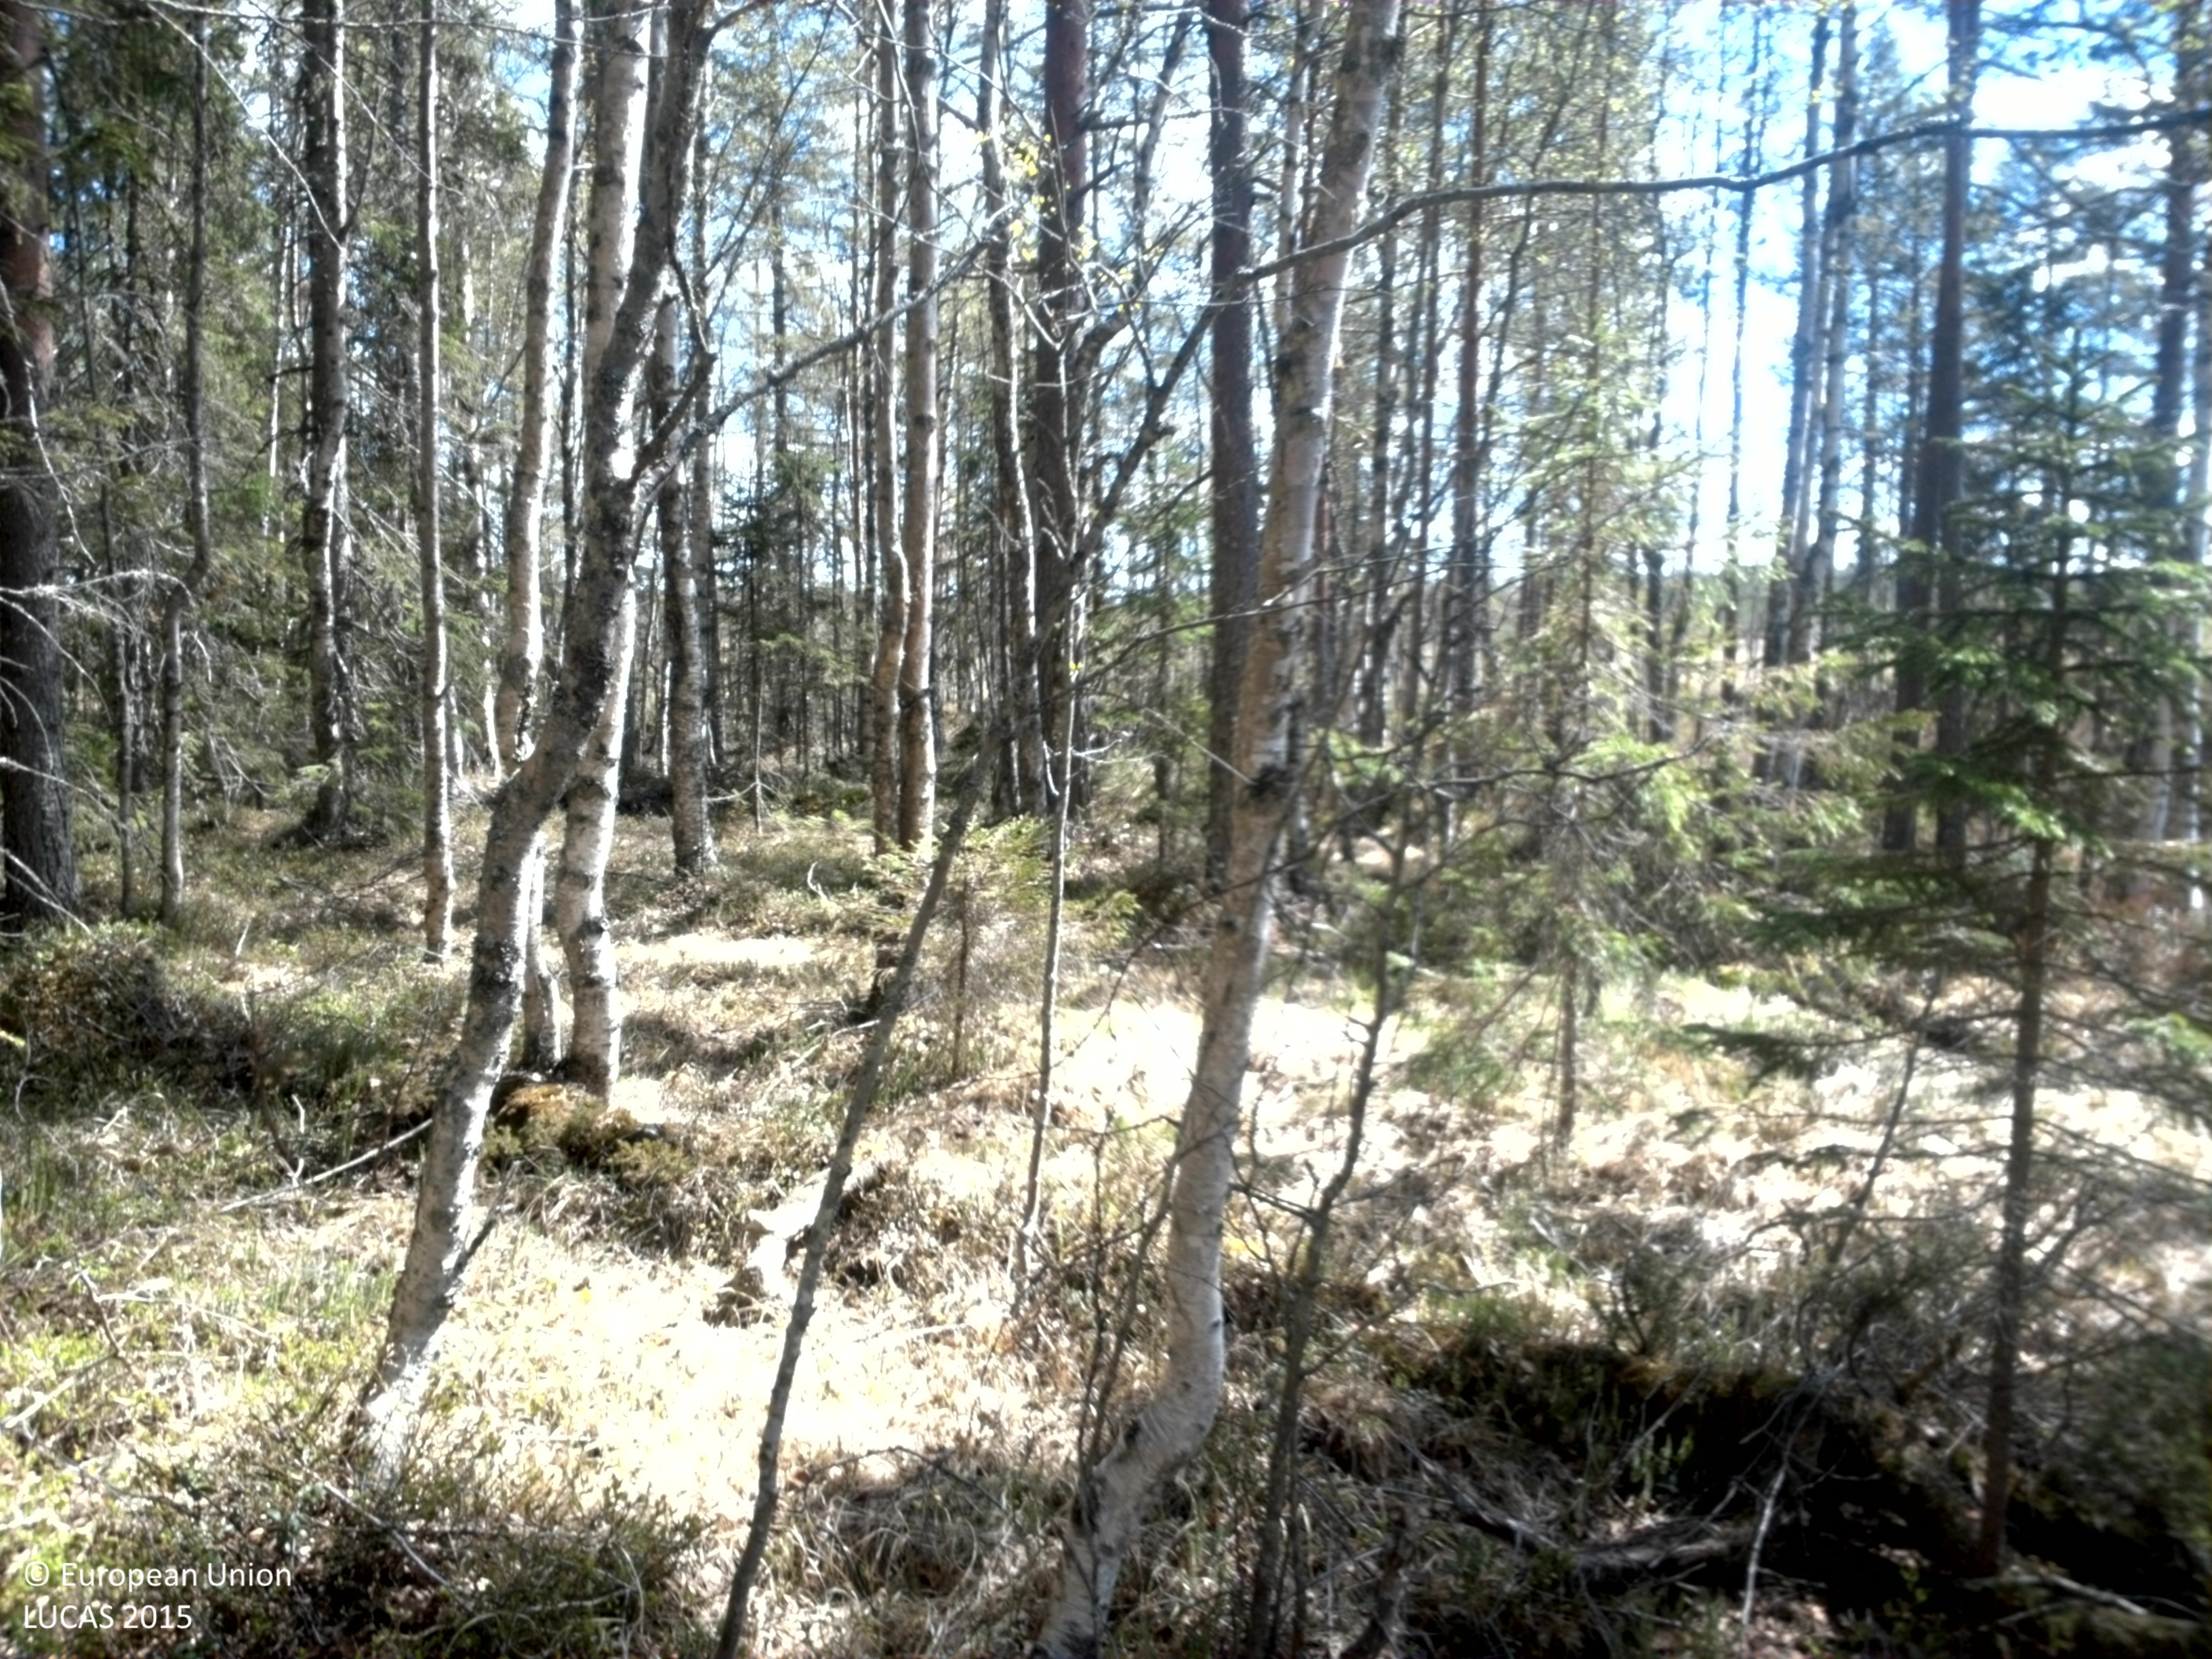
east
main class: Woodland
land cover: Pine dominated mixed woodland
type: boreal forest
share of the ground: 50 - 75 %
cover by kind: coniferous forest trees 50 %, broadleaved forest trees 25 %, herbaceous plants 15 %, shrubs 10 %
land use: Forestry
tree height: > 5 m
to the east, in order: Pine dominated mixed woodland; Ditches and canals; Pine dominated mixed woodland; Peatbogs
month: June
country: SE
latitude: 61.2041
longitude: 13.3569
